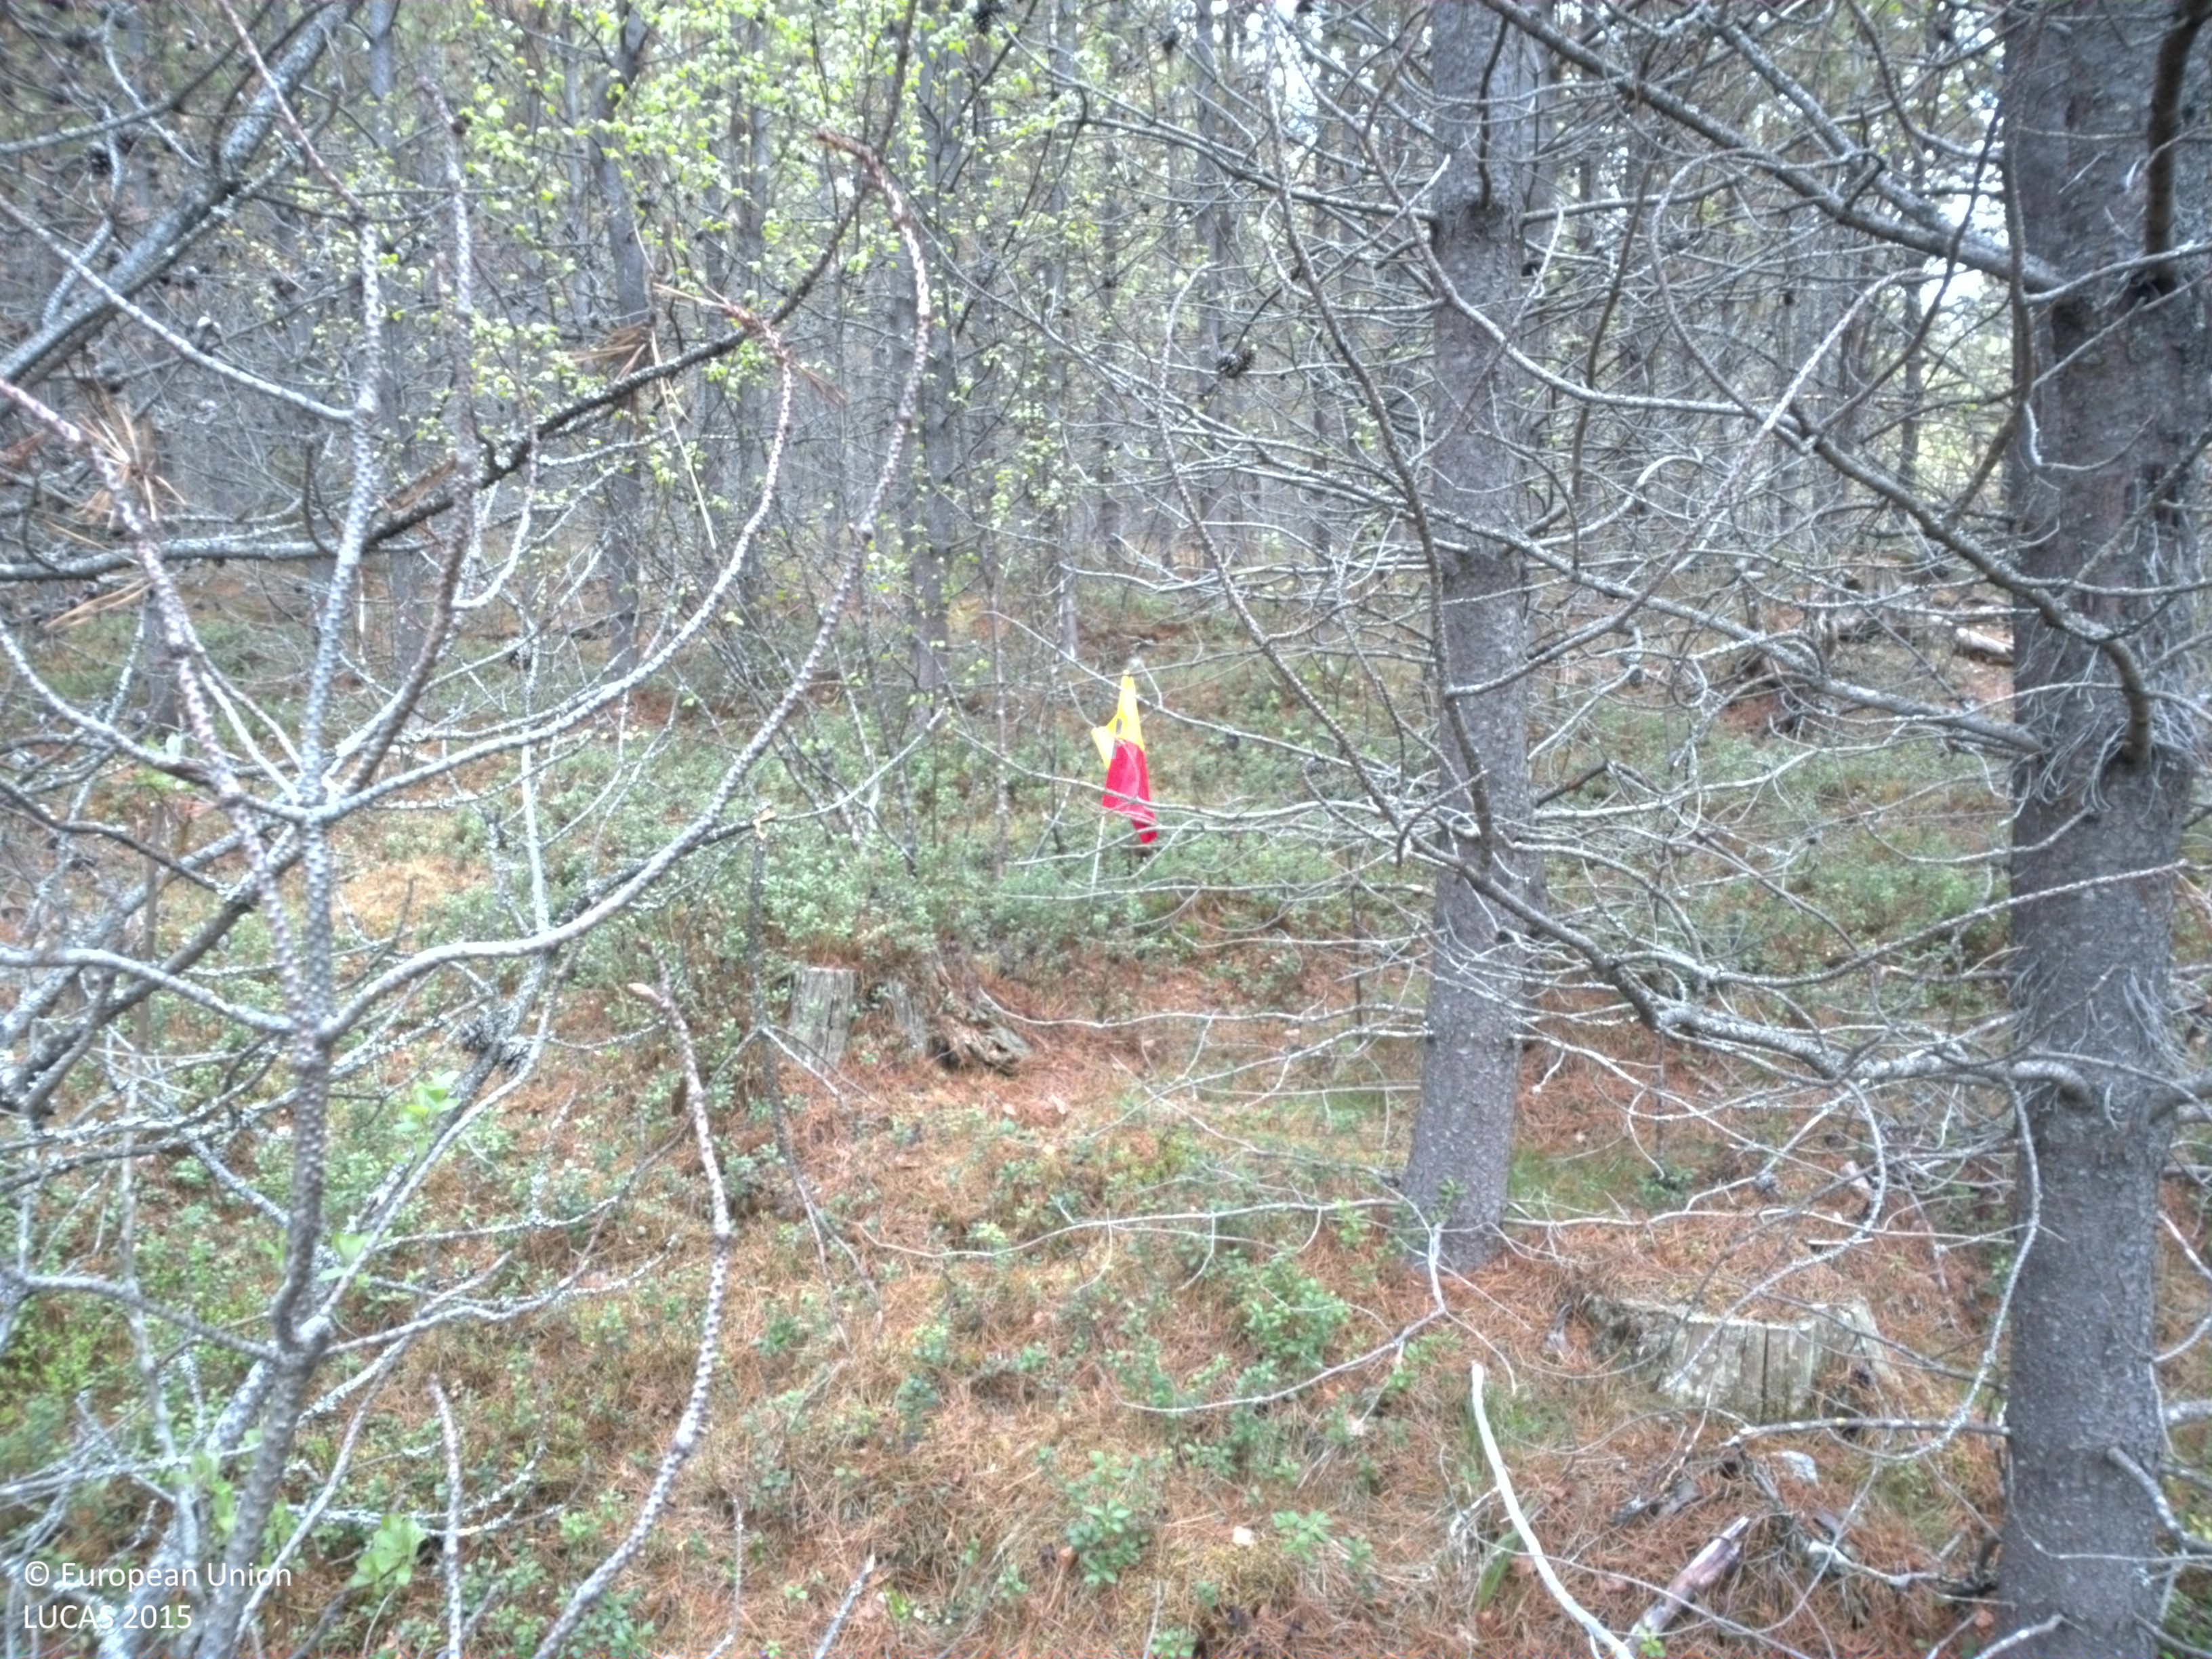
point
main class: Woodland
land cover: Pine dominated coniferous woodland
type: exotic forest
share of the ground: > 75 %
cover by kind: coniferous forest trees 75 %, herbaceous plants 10 %, lichens and mosses 10 %, broadleaved forest trees 5 %
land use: Forestry
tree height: > 5 m
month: June
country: SE
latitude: 64.2850
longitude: 17.6736
